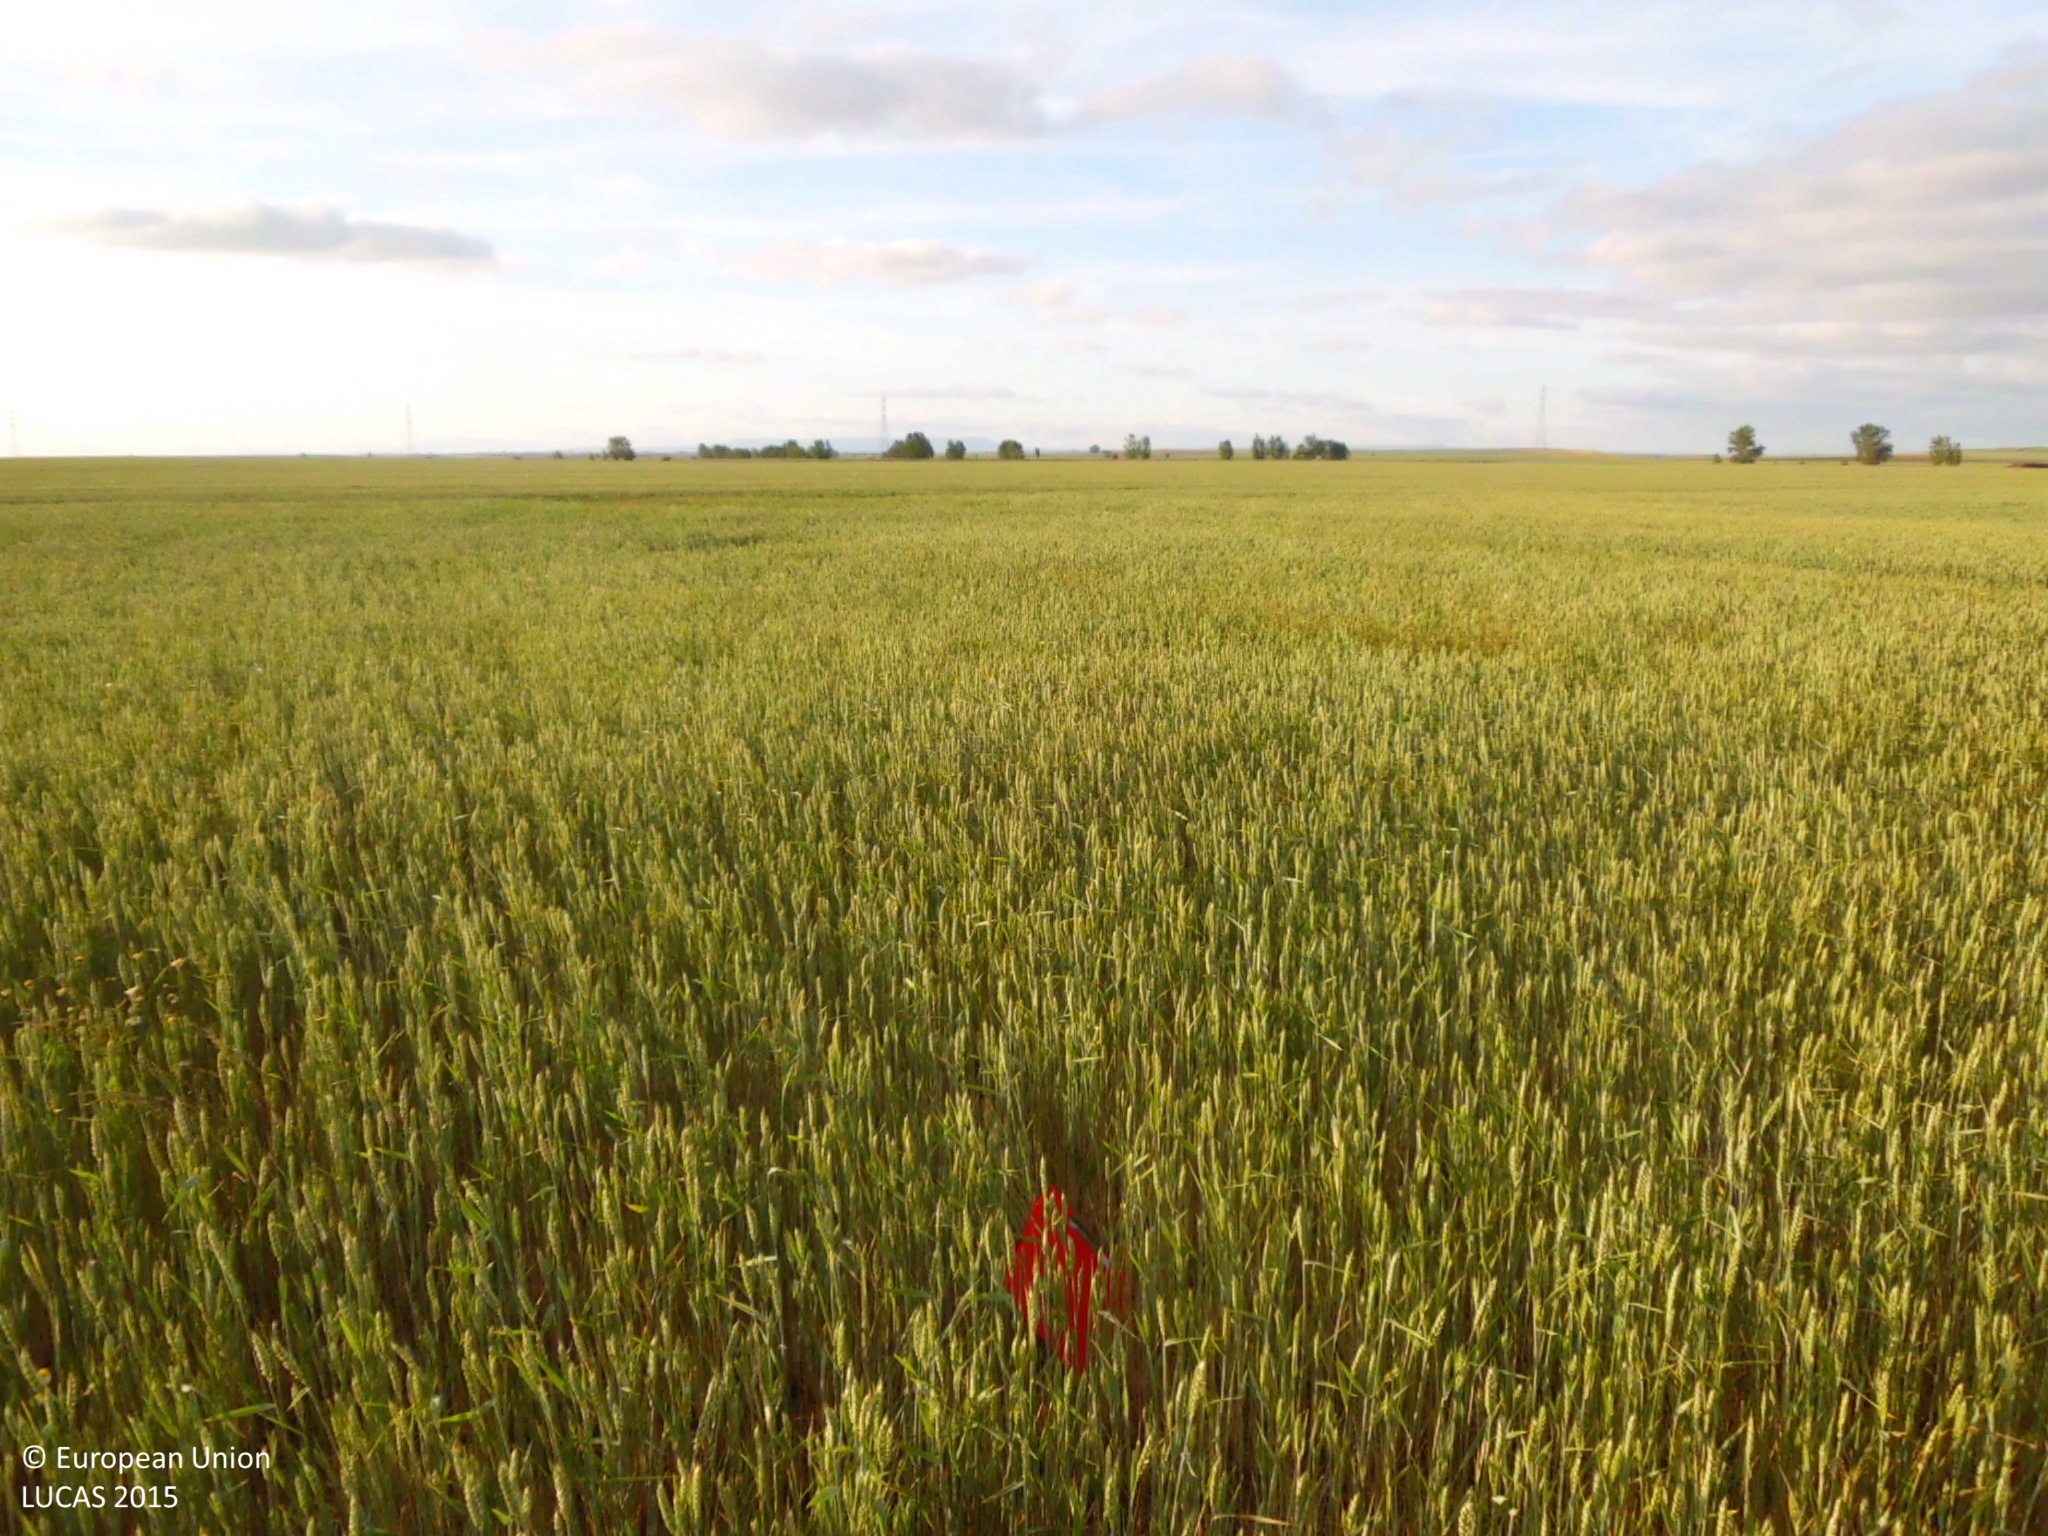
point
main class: Cropland
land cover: Common wheat
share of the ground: > 75 %
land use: Agriculture (excluding fallow land and kitchen gardens)
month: May
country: ES
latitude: 42.3455
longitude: -4.1856
